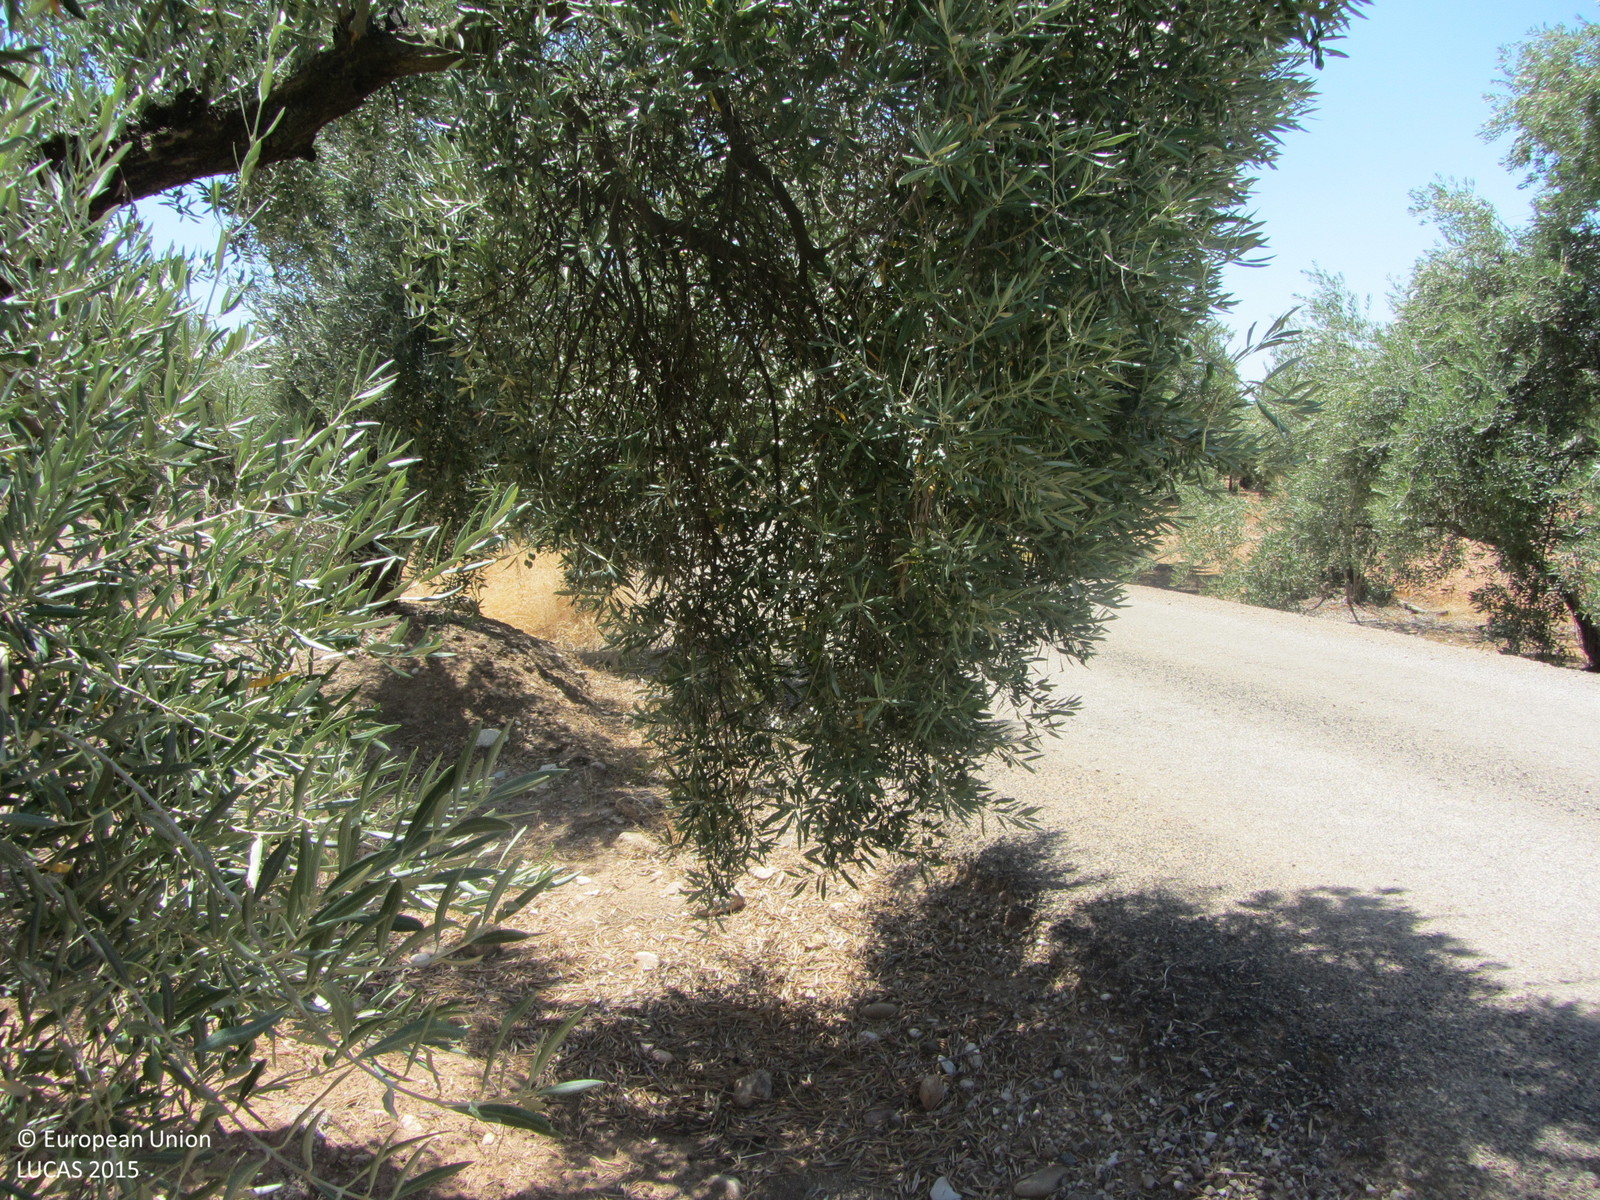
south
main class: Cropland
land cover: Olive groves
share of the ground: 25 - 50 %
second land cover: Other bare soil
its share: > 75 %
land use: Agriculture (excluding fallow land and kitchen gardens)
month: July
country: ES
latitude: 38.0296
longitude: -3.8702
